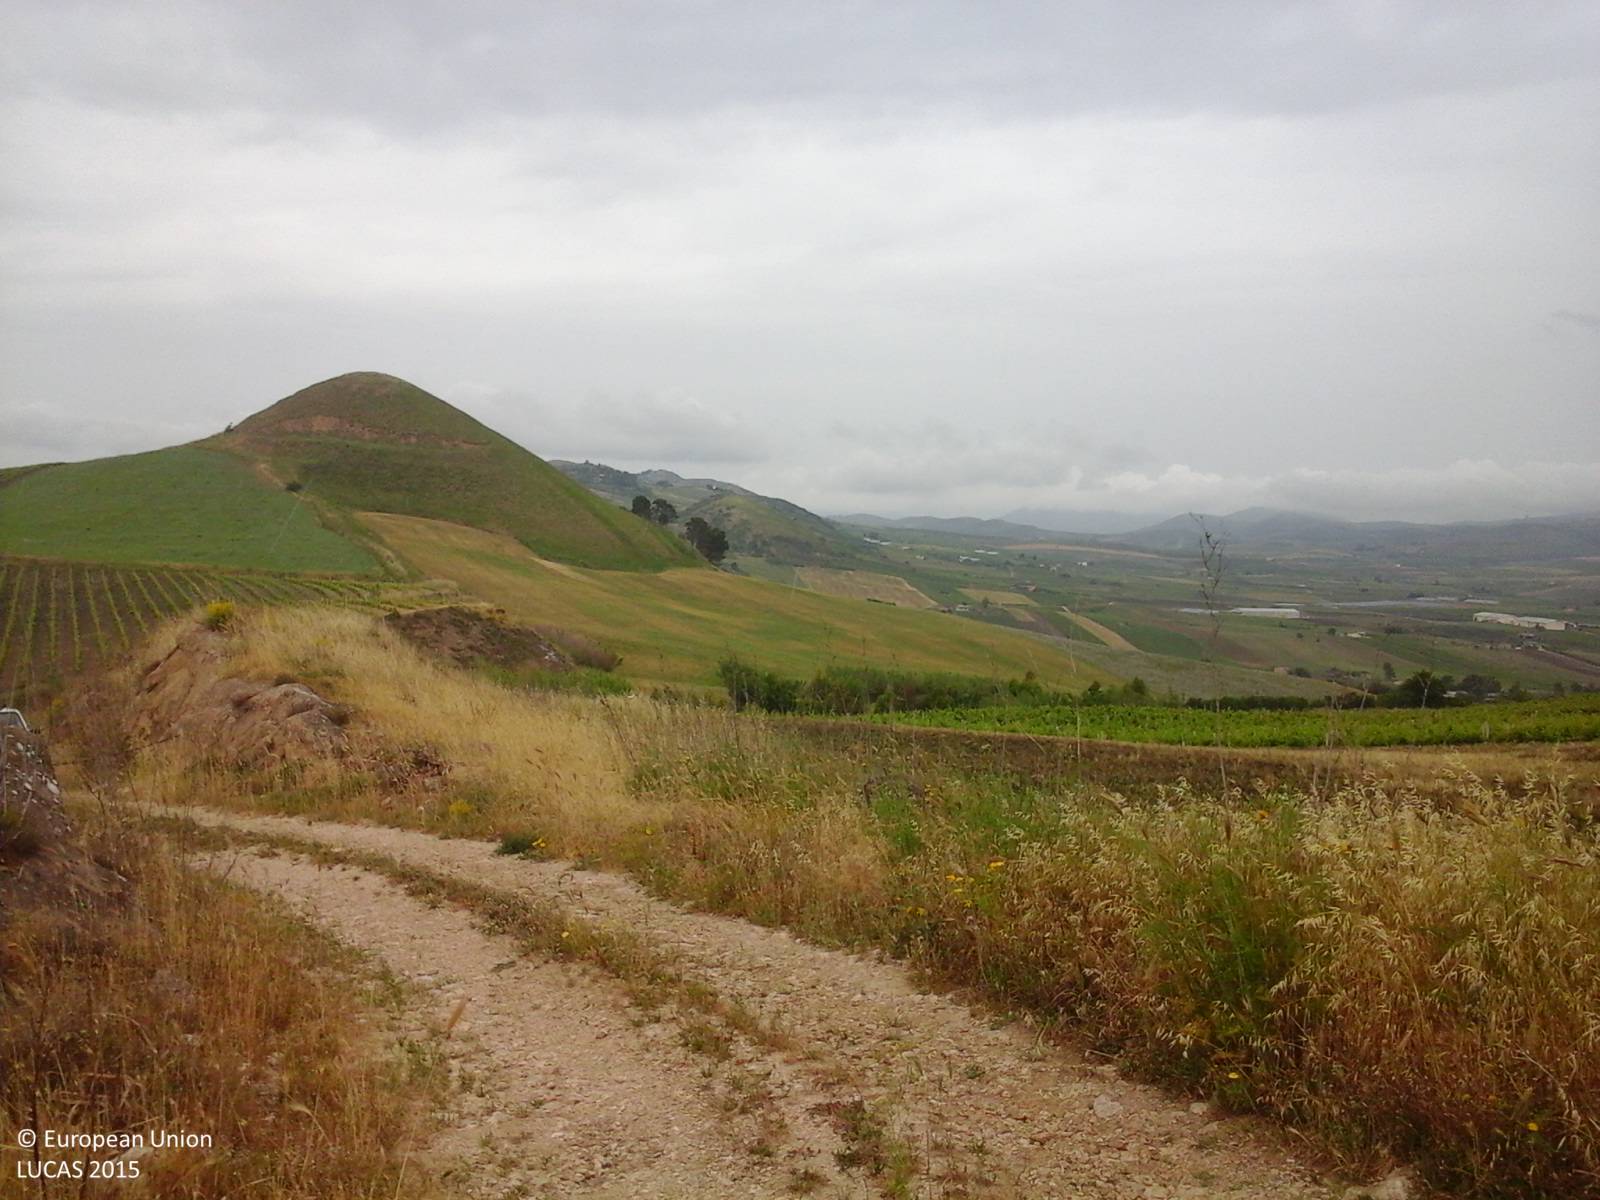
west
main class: Grassland
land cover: Grassland without tree/shrub cover
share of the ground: > 75 %
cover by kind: herbaceous plants 100 %
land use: Agriculture (excluding fallow land and kitchen gardens)
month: May
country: IT
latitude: 37.8952
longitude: 13.1499
